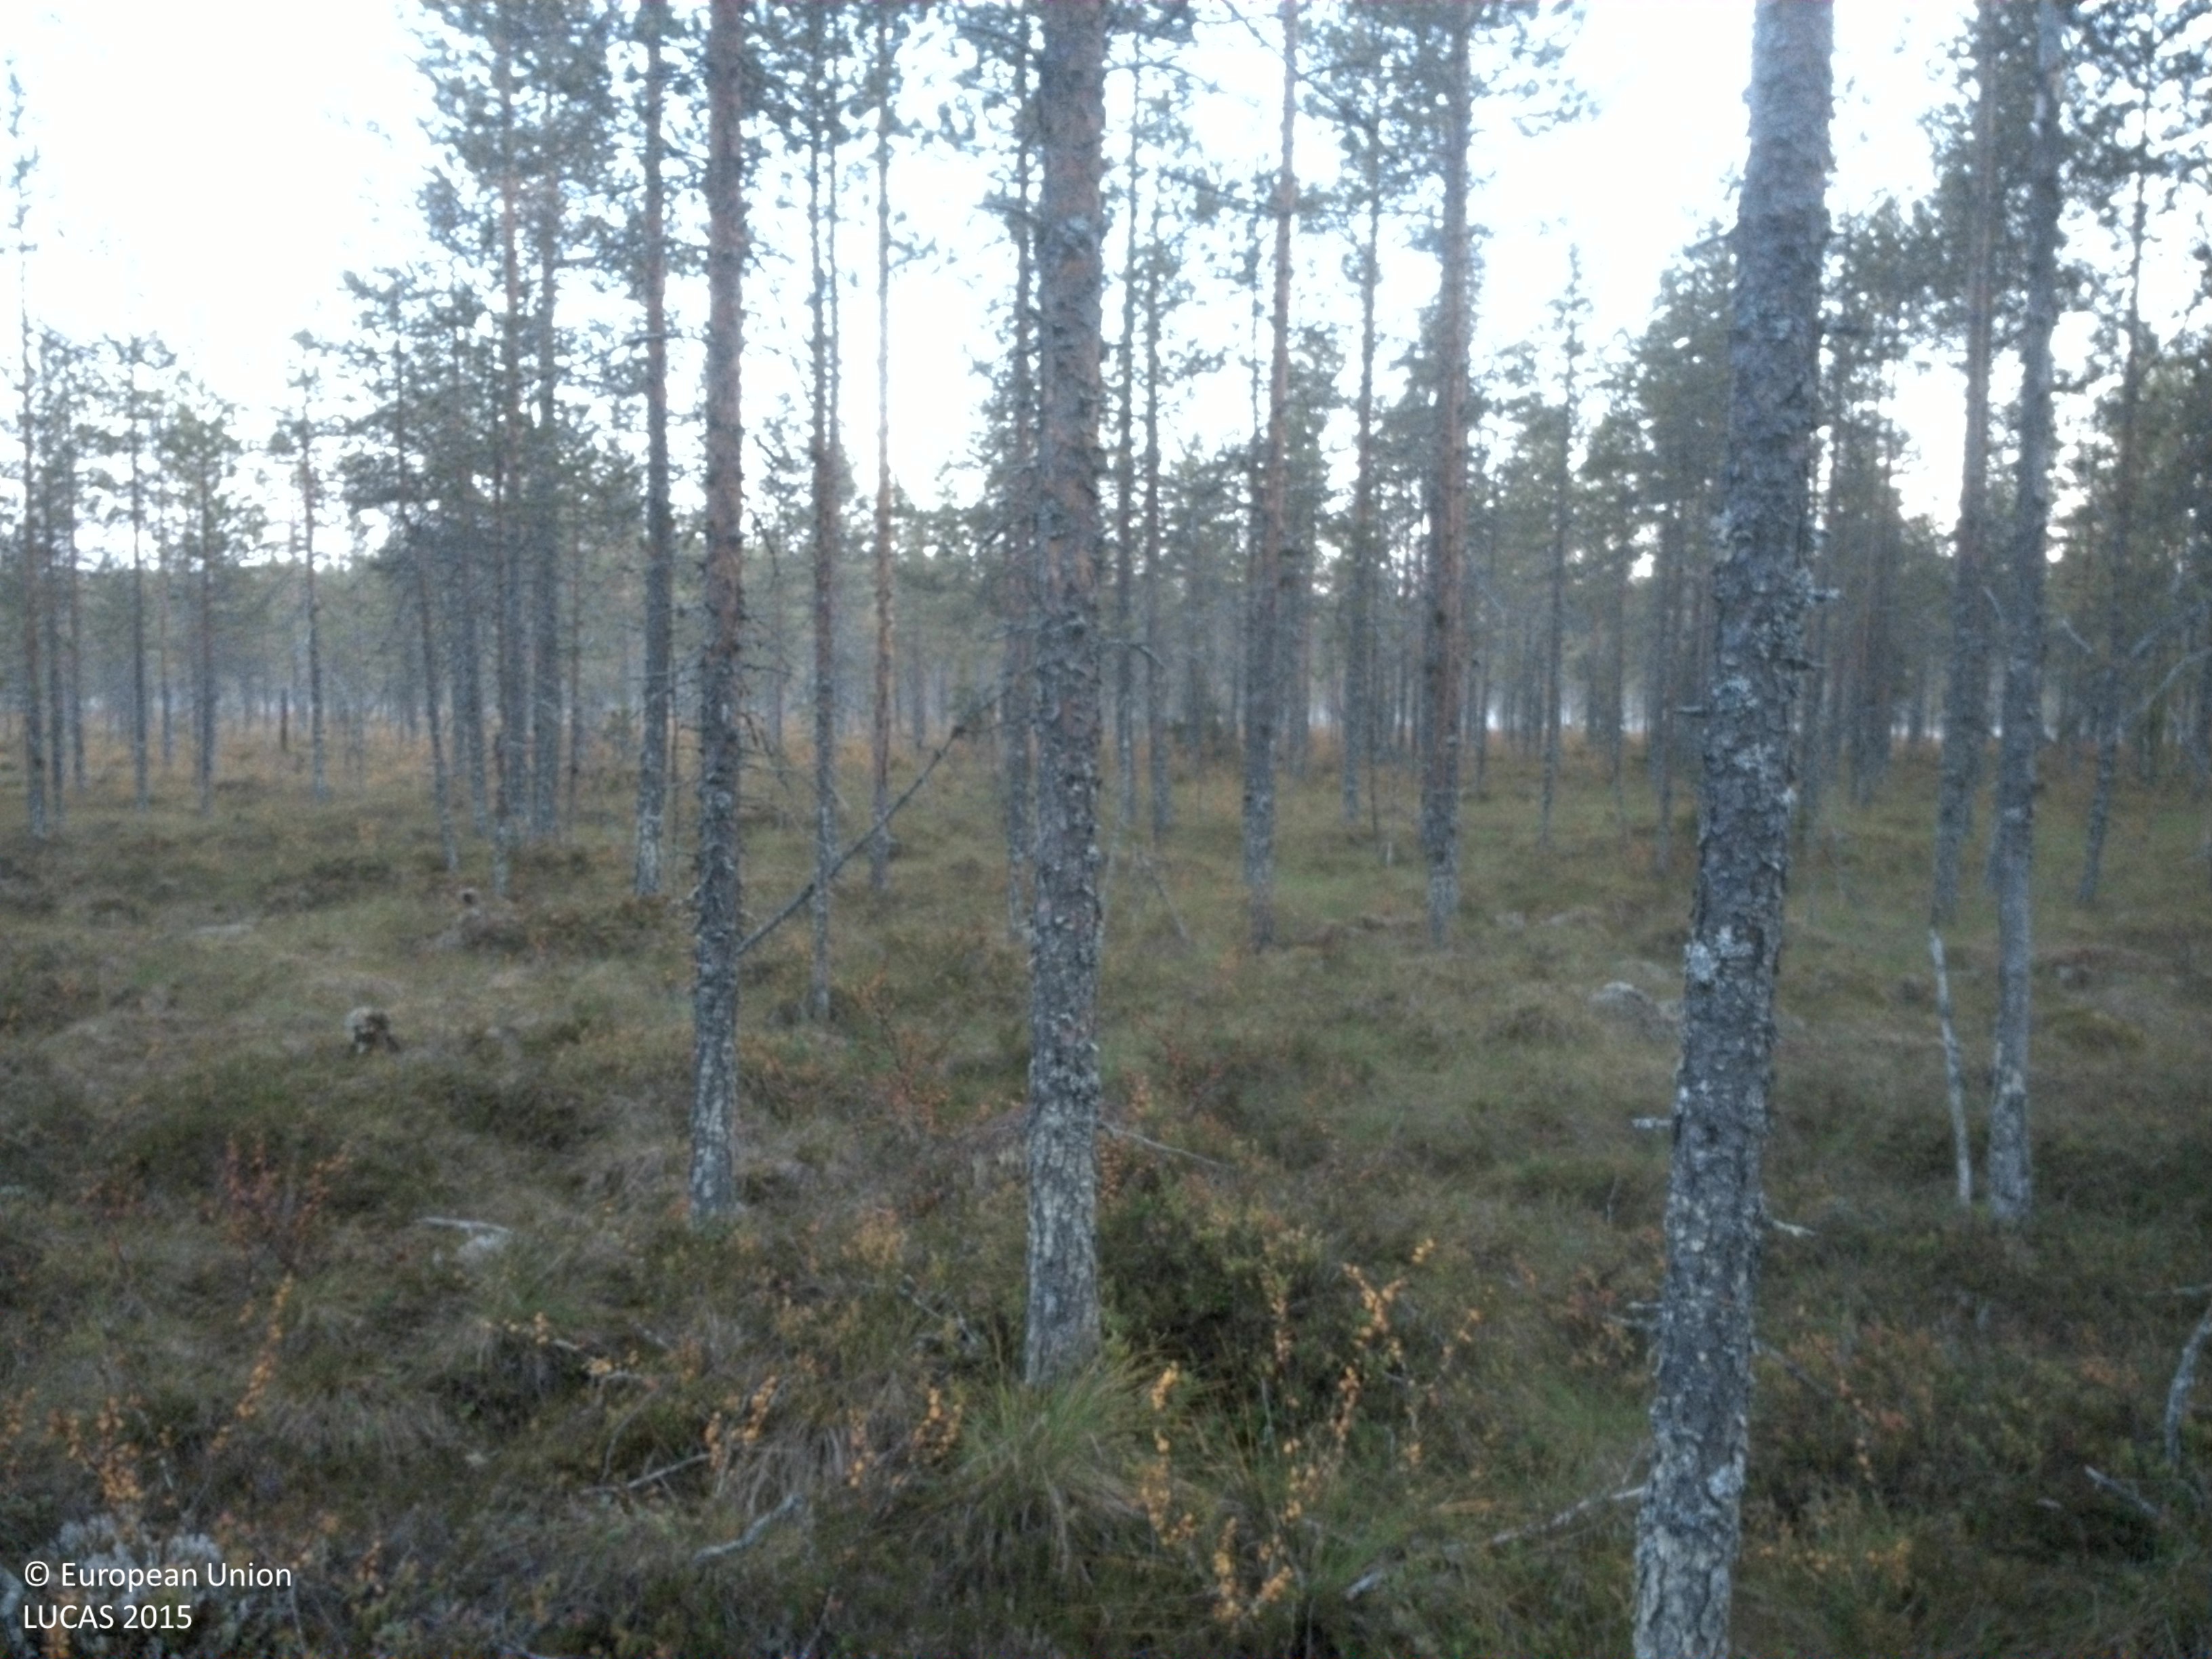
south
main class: Woodland
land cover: Pine dominated coniferous woodland
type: boreal forest
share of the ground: 25 - 50 %
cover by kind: coniferous forest trees 45 %, herbaceous plants 30 %, shrubs 15 %, lichens and mosses 10 %
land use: Forestry
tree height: > 5 m
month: September
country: SE
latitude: 64.3846
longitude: 20.1133
